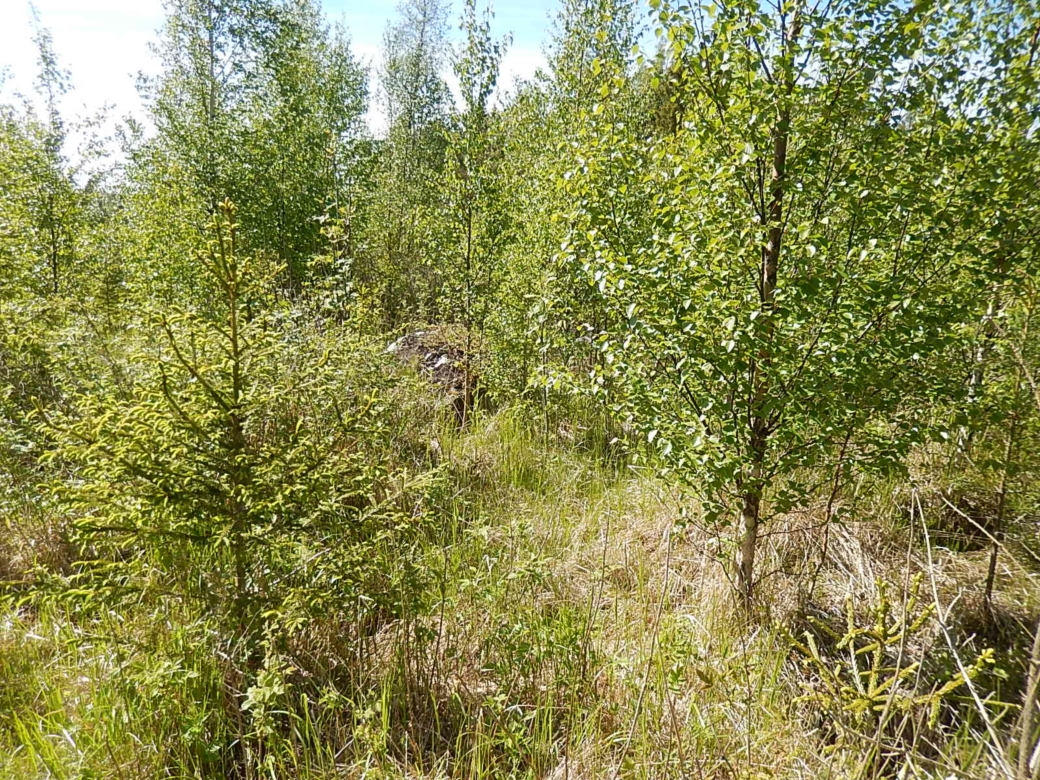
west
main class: Woodland
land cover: Other mixed woodland
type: boreal forest
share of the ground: 50 - 75 %
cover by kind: broadleaved forest trees 45 %, herbaceous plants 30 %, coniferous forest trees 25 %
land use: Forestry
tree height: < 5 m
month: June
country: FI
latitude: 62.0100
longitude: 21.4491
